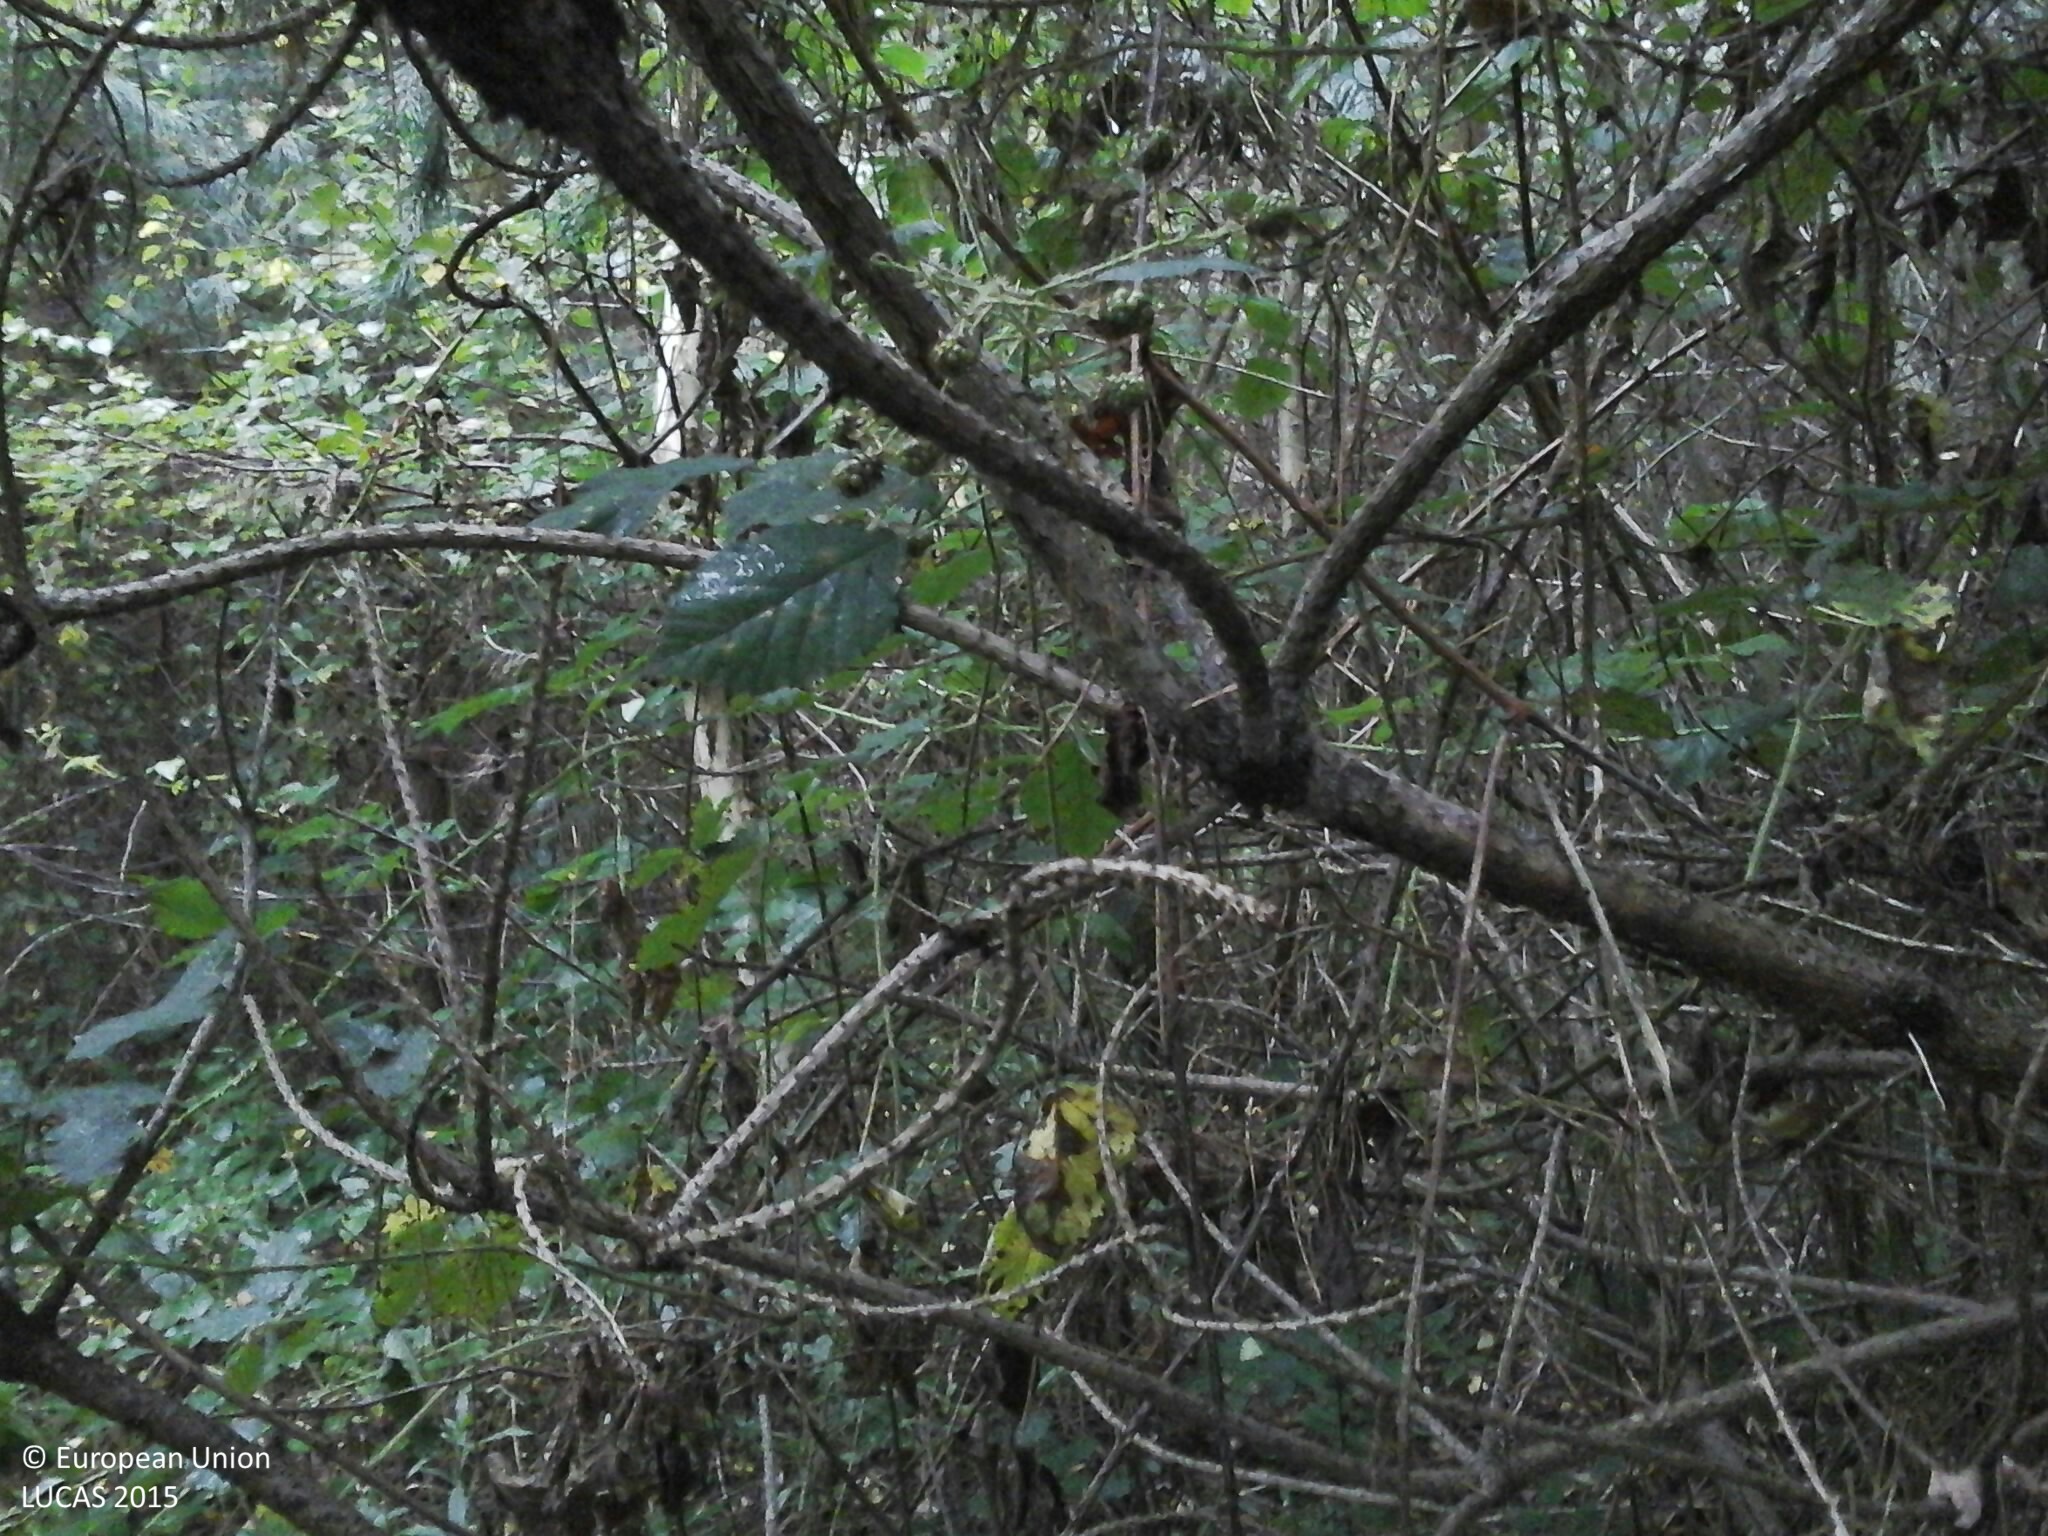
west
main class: Woodland
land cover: Pine dominated coniferous woodland
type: hemiboreal forest and nemoral coniferous forest and mixed broadleaved-coniferous forest
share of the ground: 50 - 75 %
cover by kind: coniferous forest trees 55 %, shrubs 20 %, broadleaved forest trees 15 %, herbaceous plants 10 %
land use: Forestry
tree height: < 5 m
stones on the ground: < 10 %
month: July
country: HU
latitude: 46.7866
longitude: 16.4860
